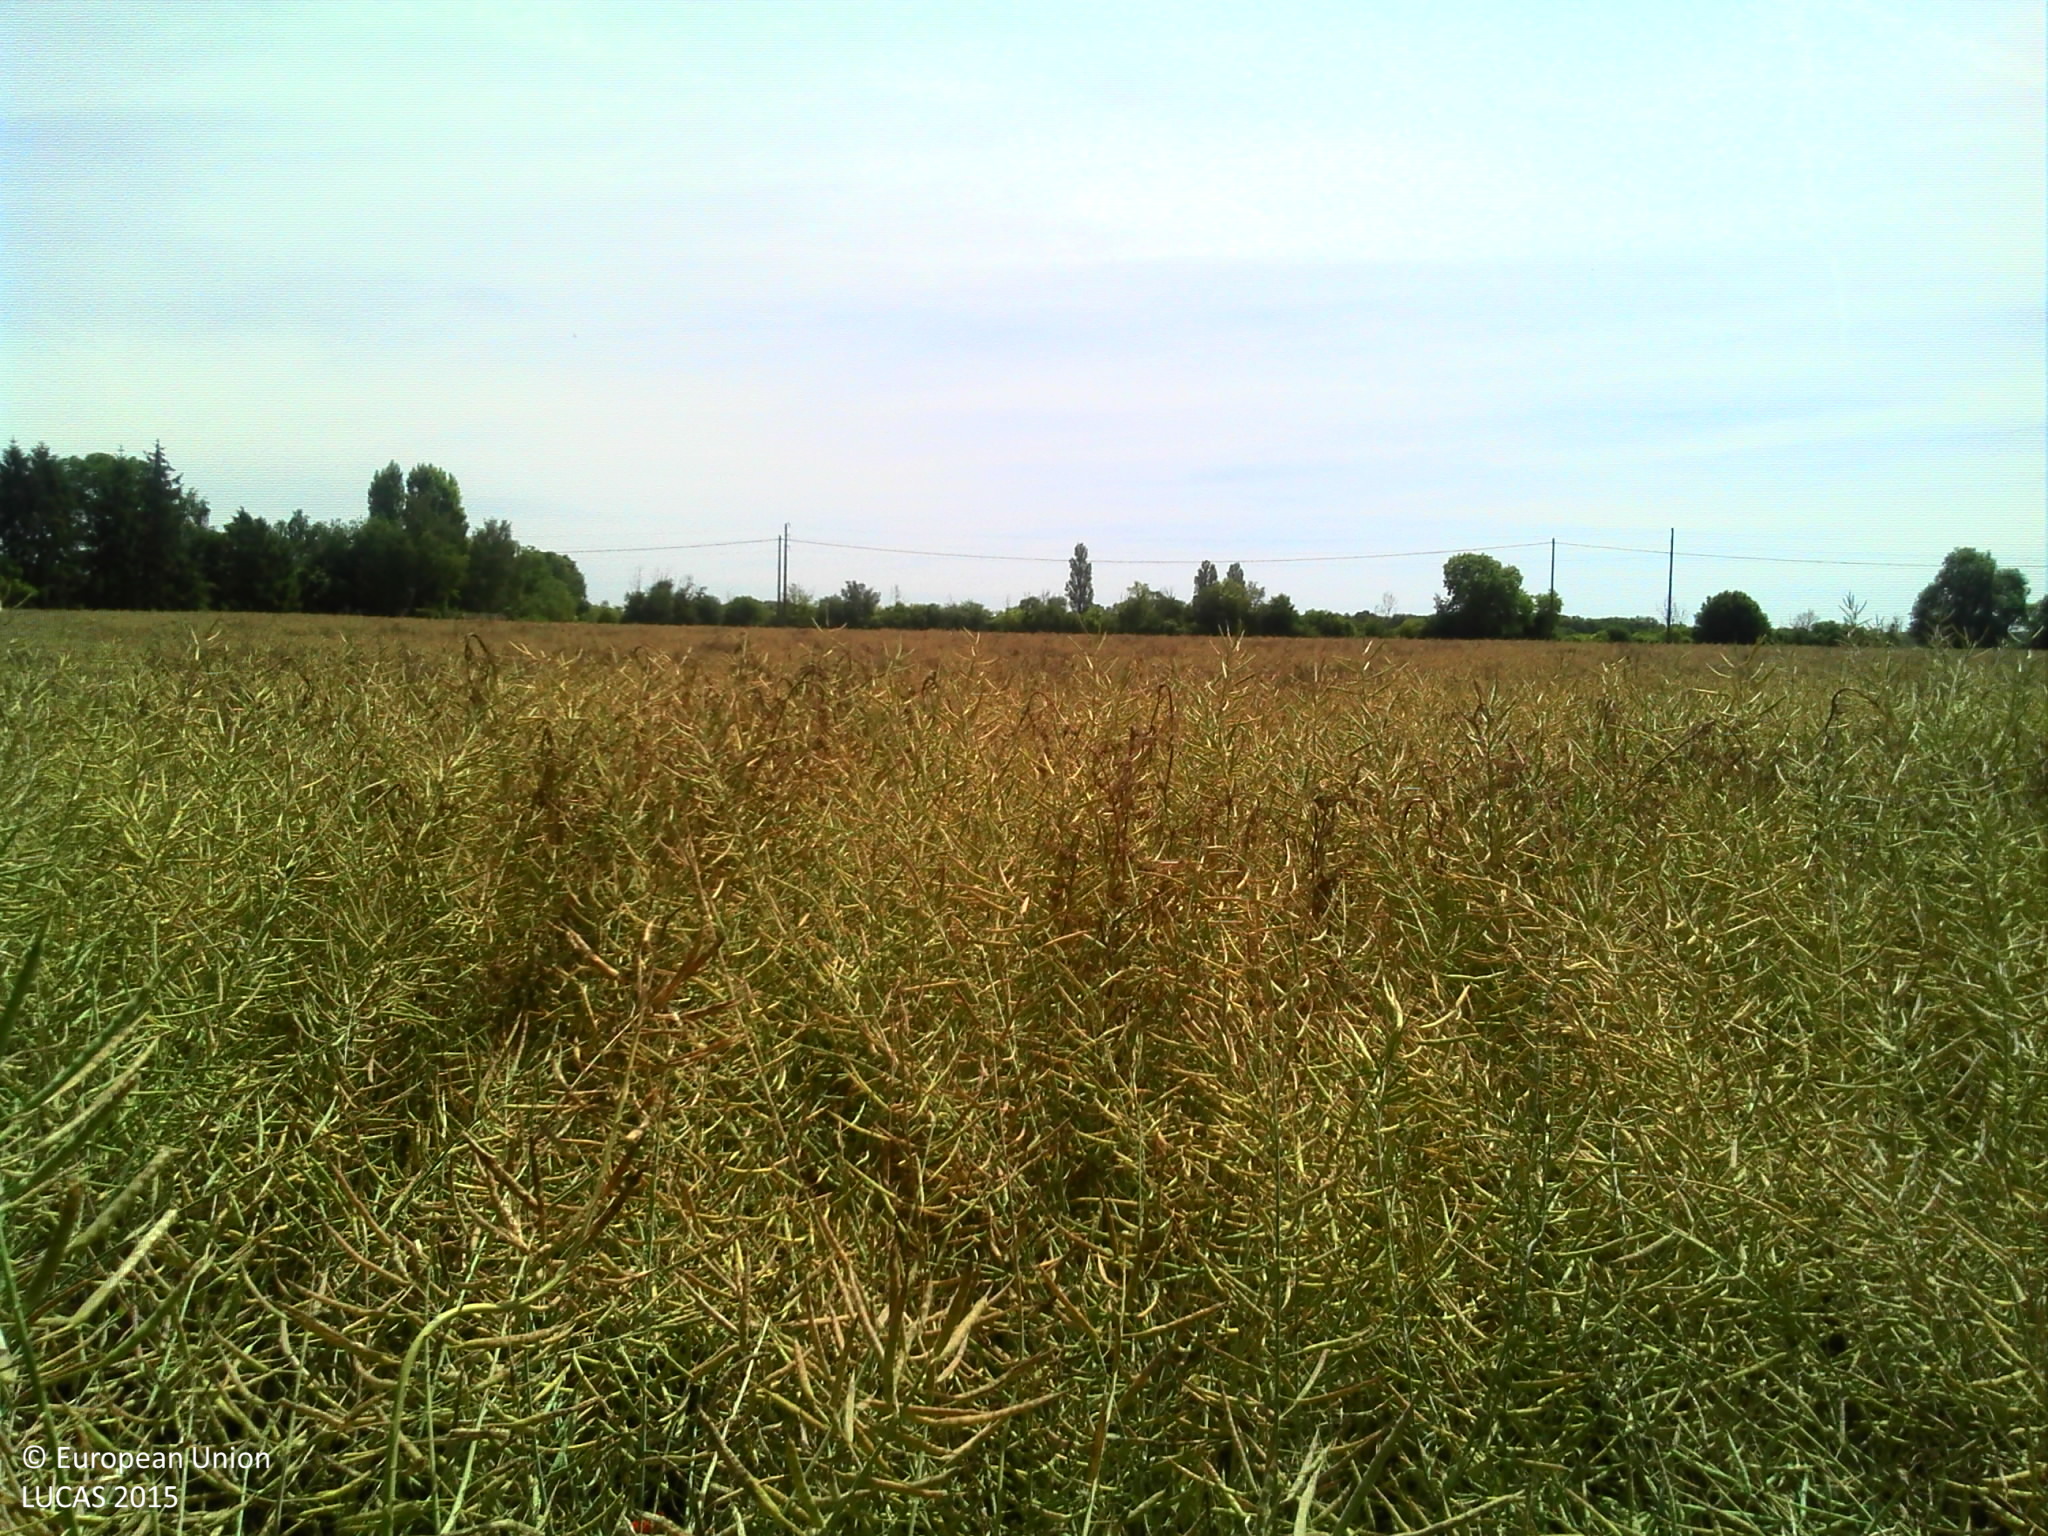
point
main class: Cropland
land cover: Rape and turnip rape
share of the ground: > 75 %
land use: Agriculture (excluding fallow land and kitchen gardens)
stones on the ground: < 10 %
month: June
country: FR
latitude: 47.7712
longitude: 2.8003
